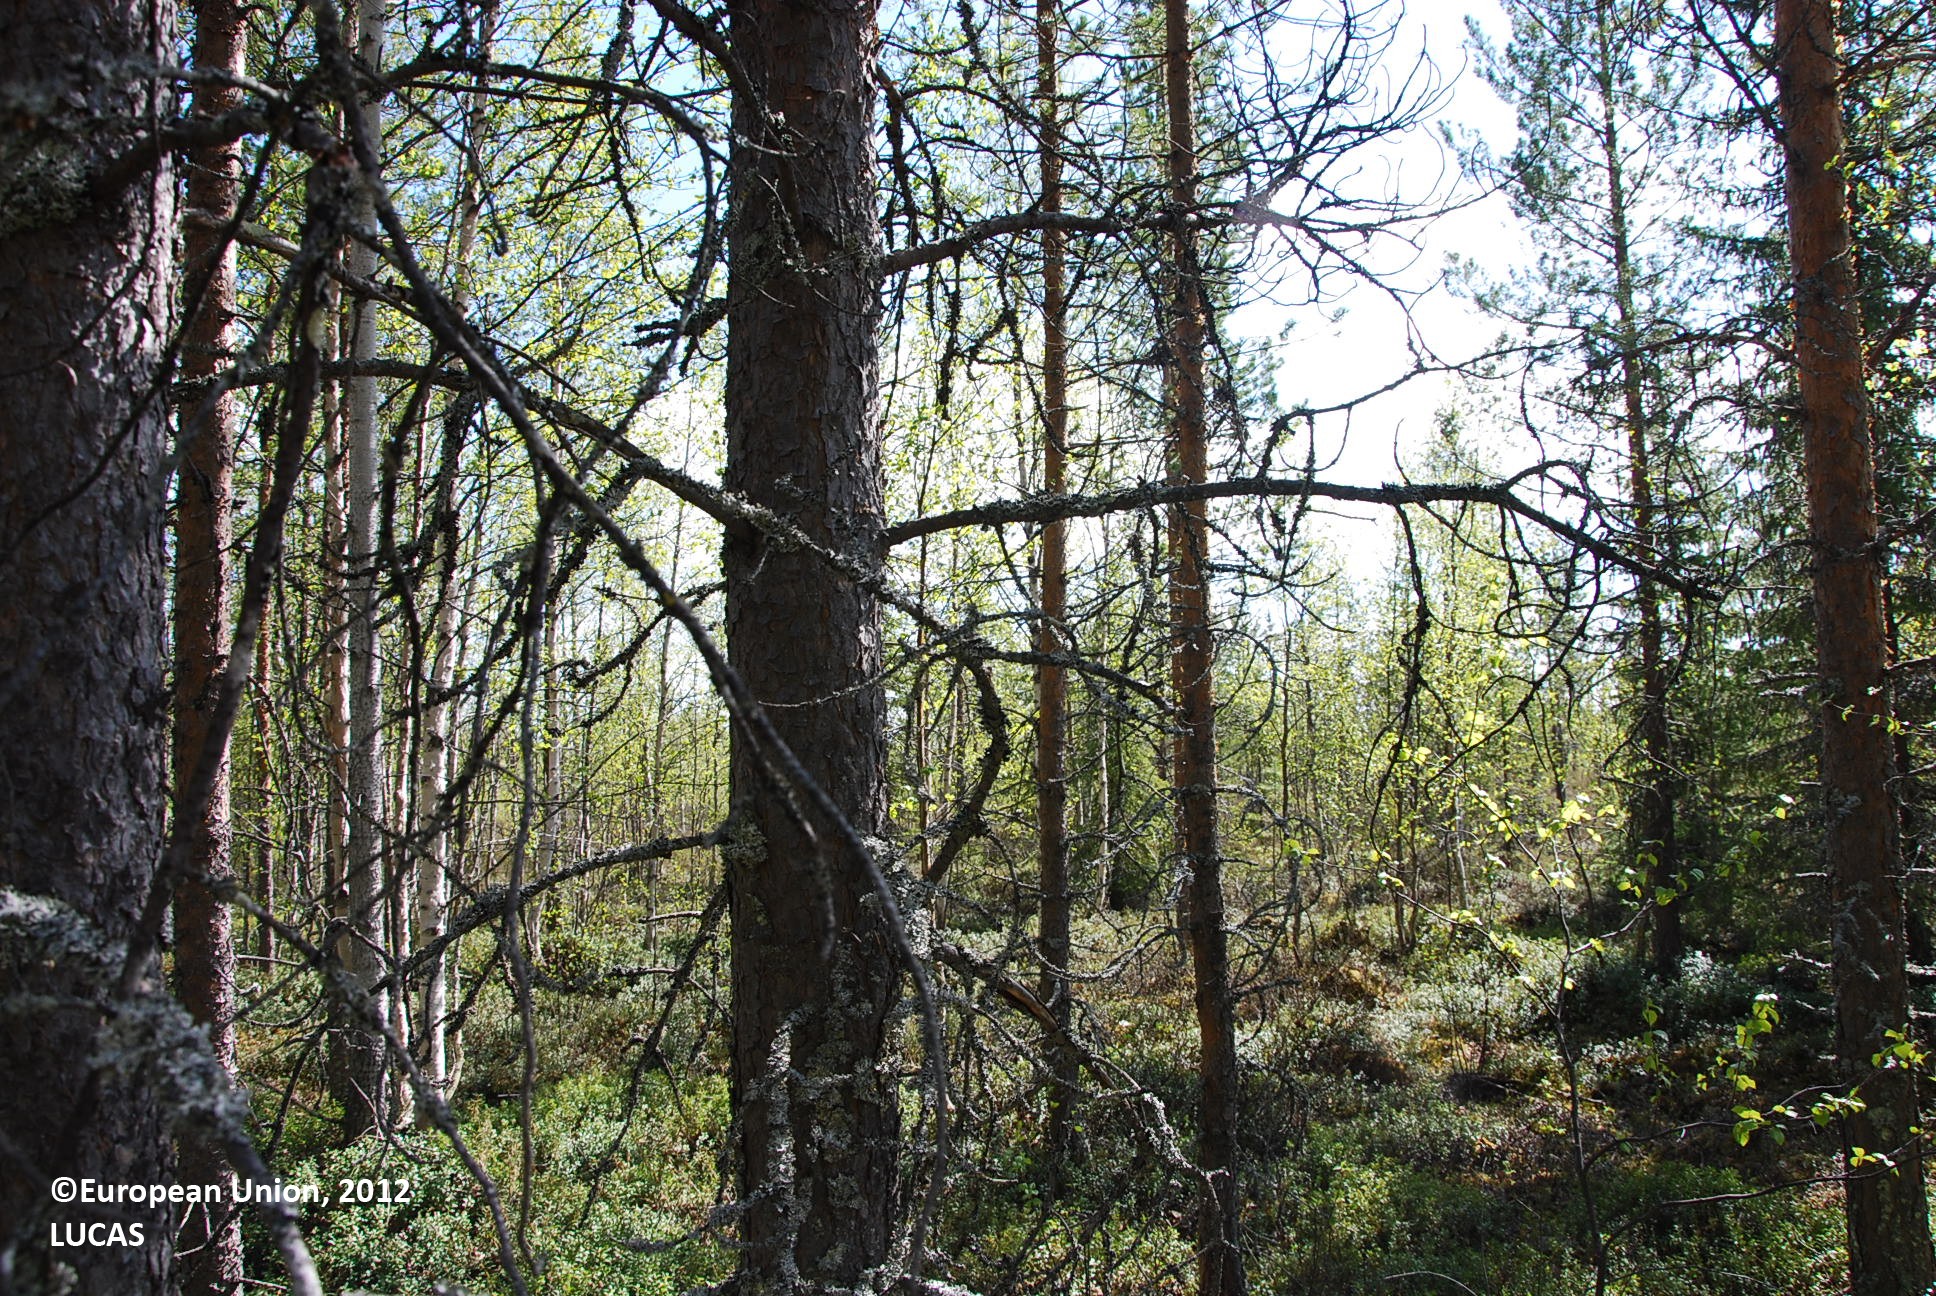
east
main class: Woodland
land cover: Pine dominated mixed woodland
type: boreal forest
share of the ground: 50 - 75 %
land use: Forestry
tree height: > 5 m
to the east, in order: Pine dominated mixed woodland; Ditches and canals; Paved roads, cycling and walking lanes; Ditches and canals; Pine dominated mixed woodland; Other mixed woodland; Pine dominated mixed woodland
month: June
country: FI
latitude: 66.9890
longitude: 28.0734
